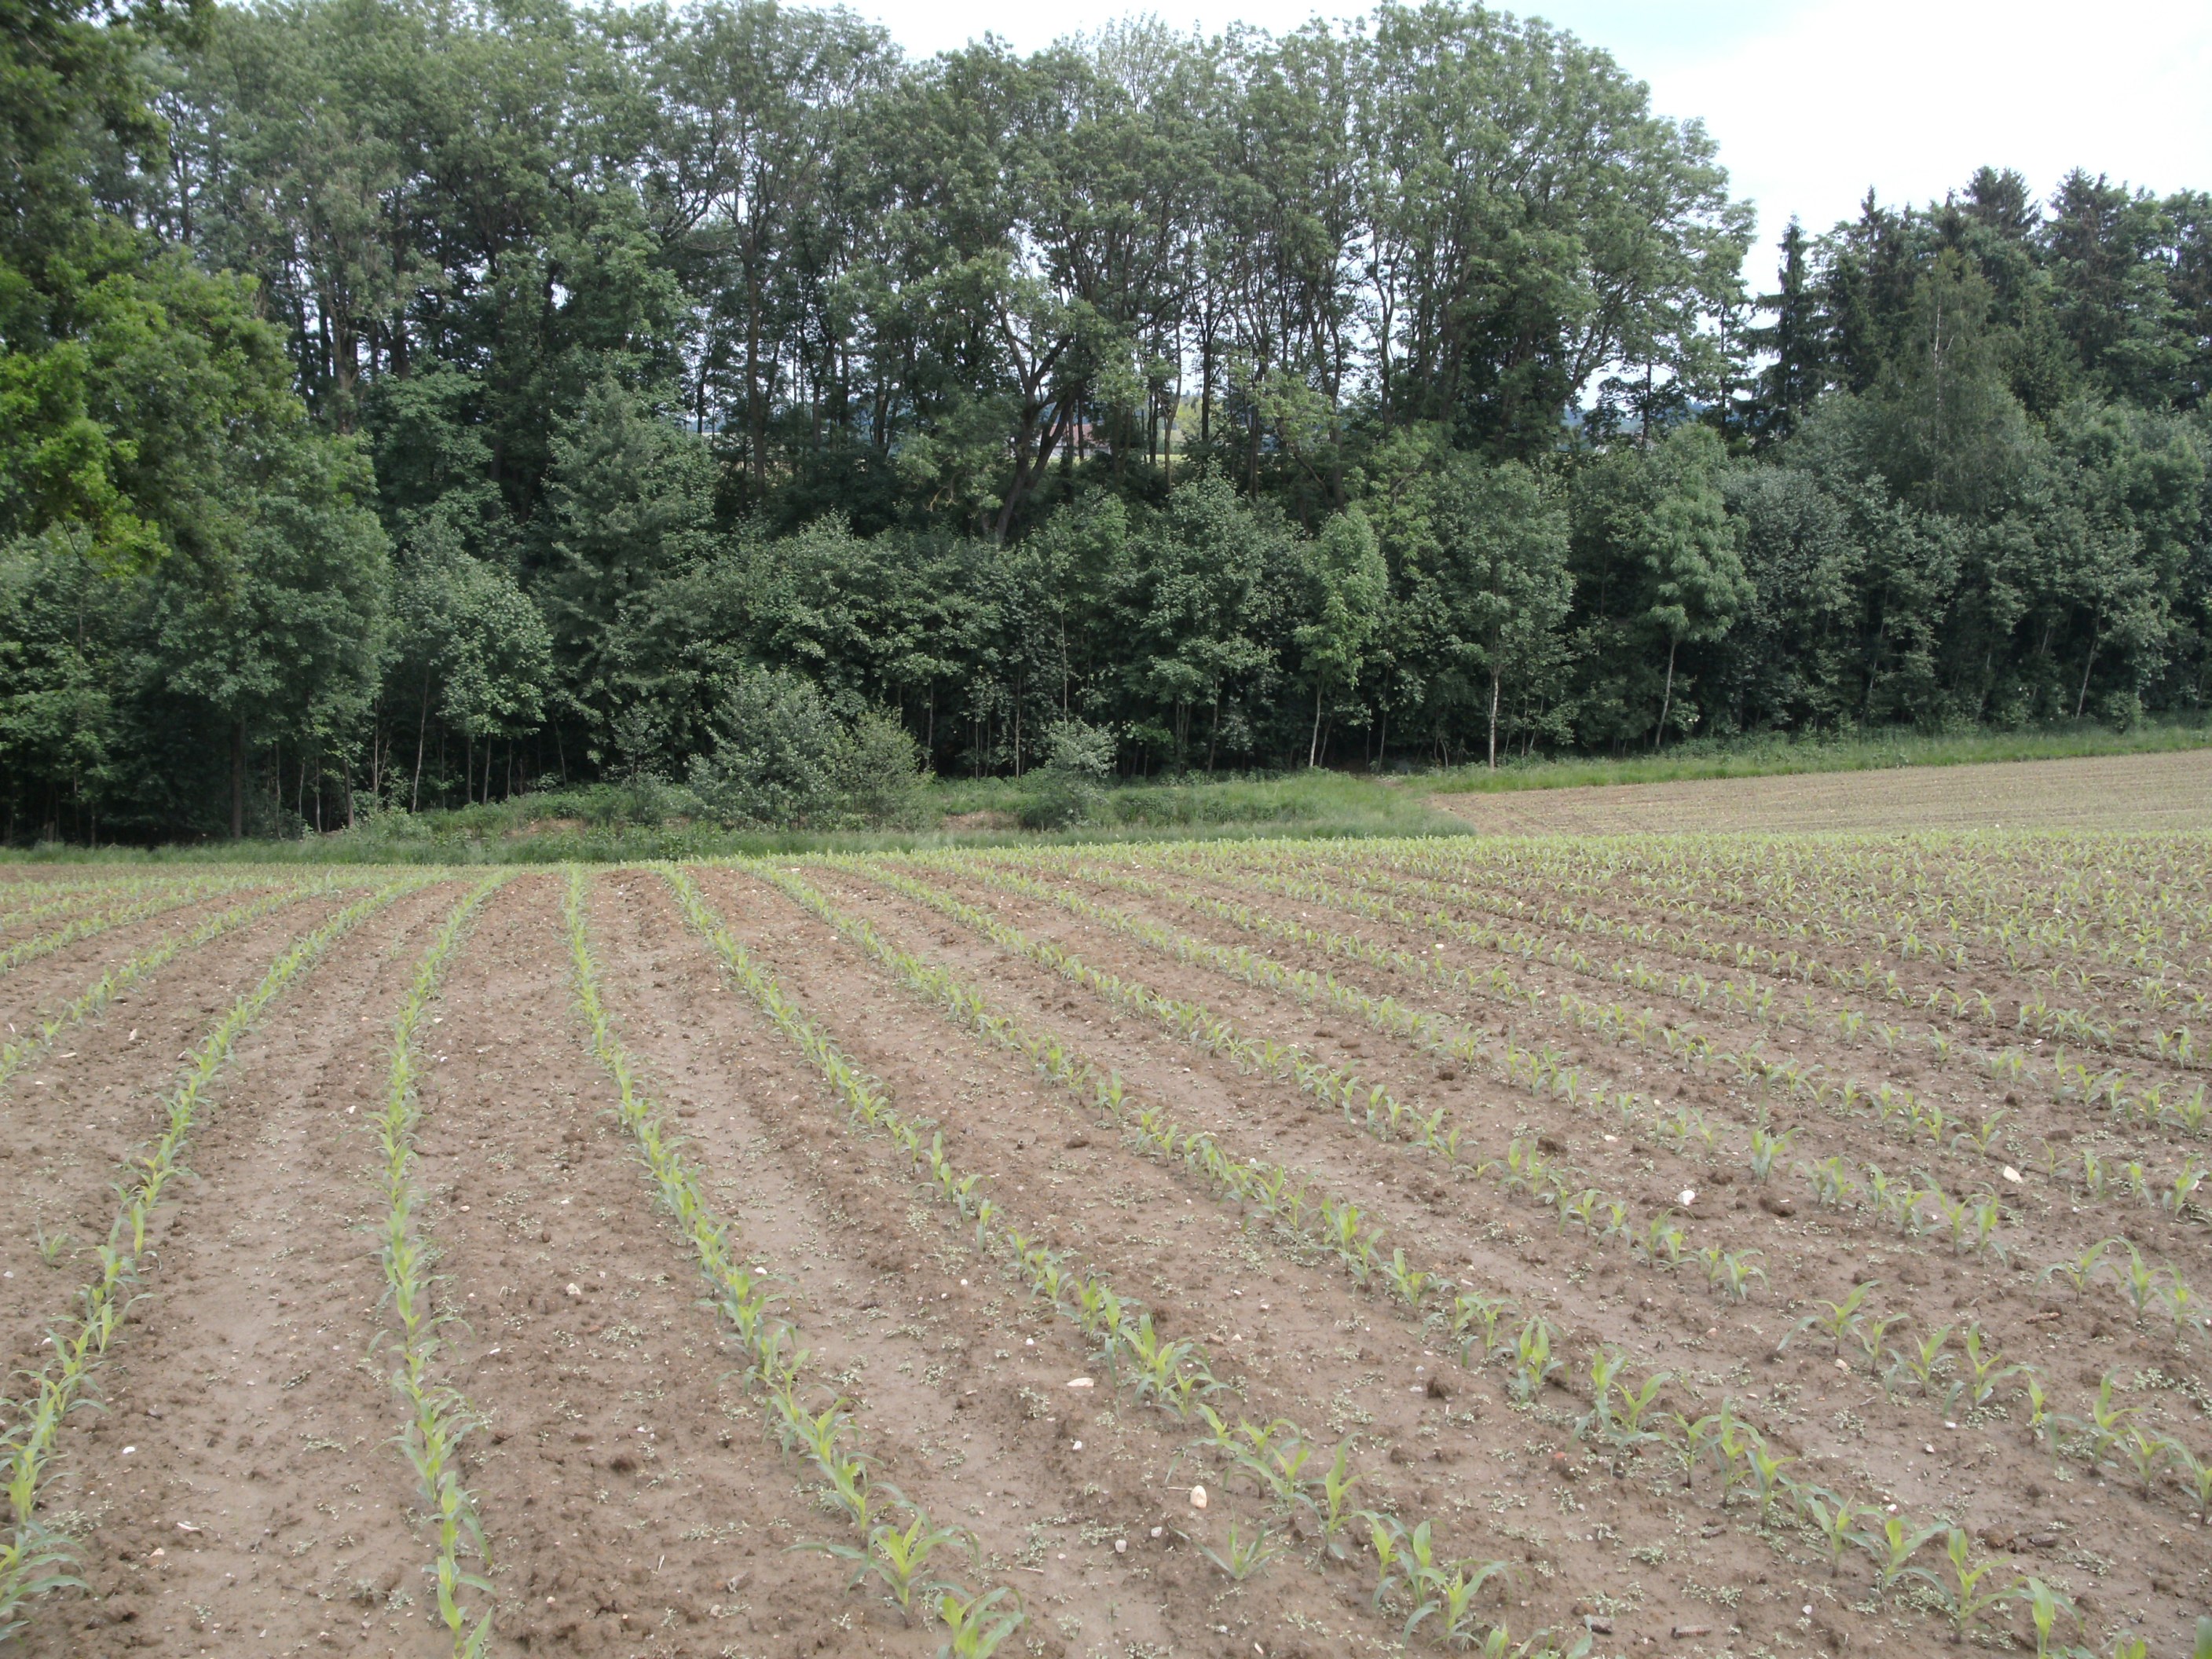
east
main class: Cropland
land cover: Maize
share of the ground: < 10 %
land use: Agriculture (excluding fallow land and kitchen gardens)
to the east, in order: Maize; Grassland with sparse tree/shrub cover; Inland fresh water bodies; Grassland without tree/shrub cover; Broadleaved woodland; Fences; Ditches and canals; Spruce dominated mixed woodland; Broadleaved woodland; Grass margins; Sunflower; Maize
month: May
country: AT
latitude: 48.0964
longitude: 14.0144
